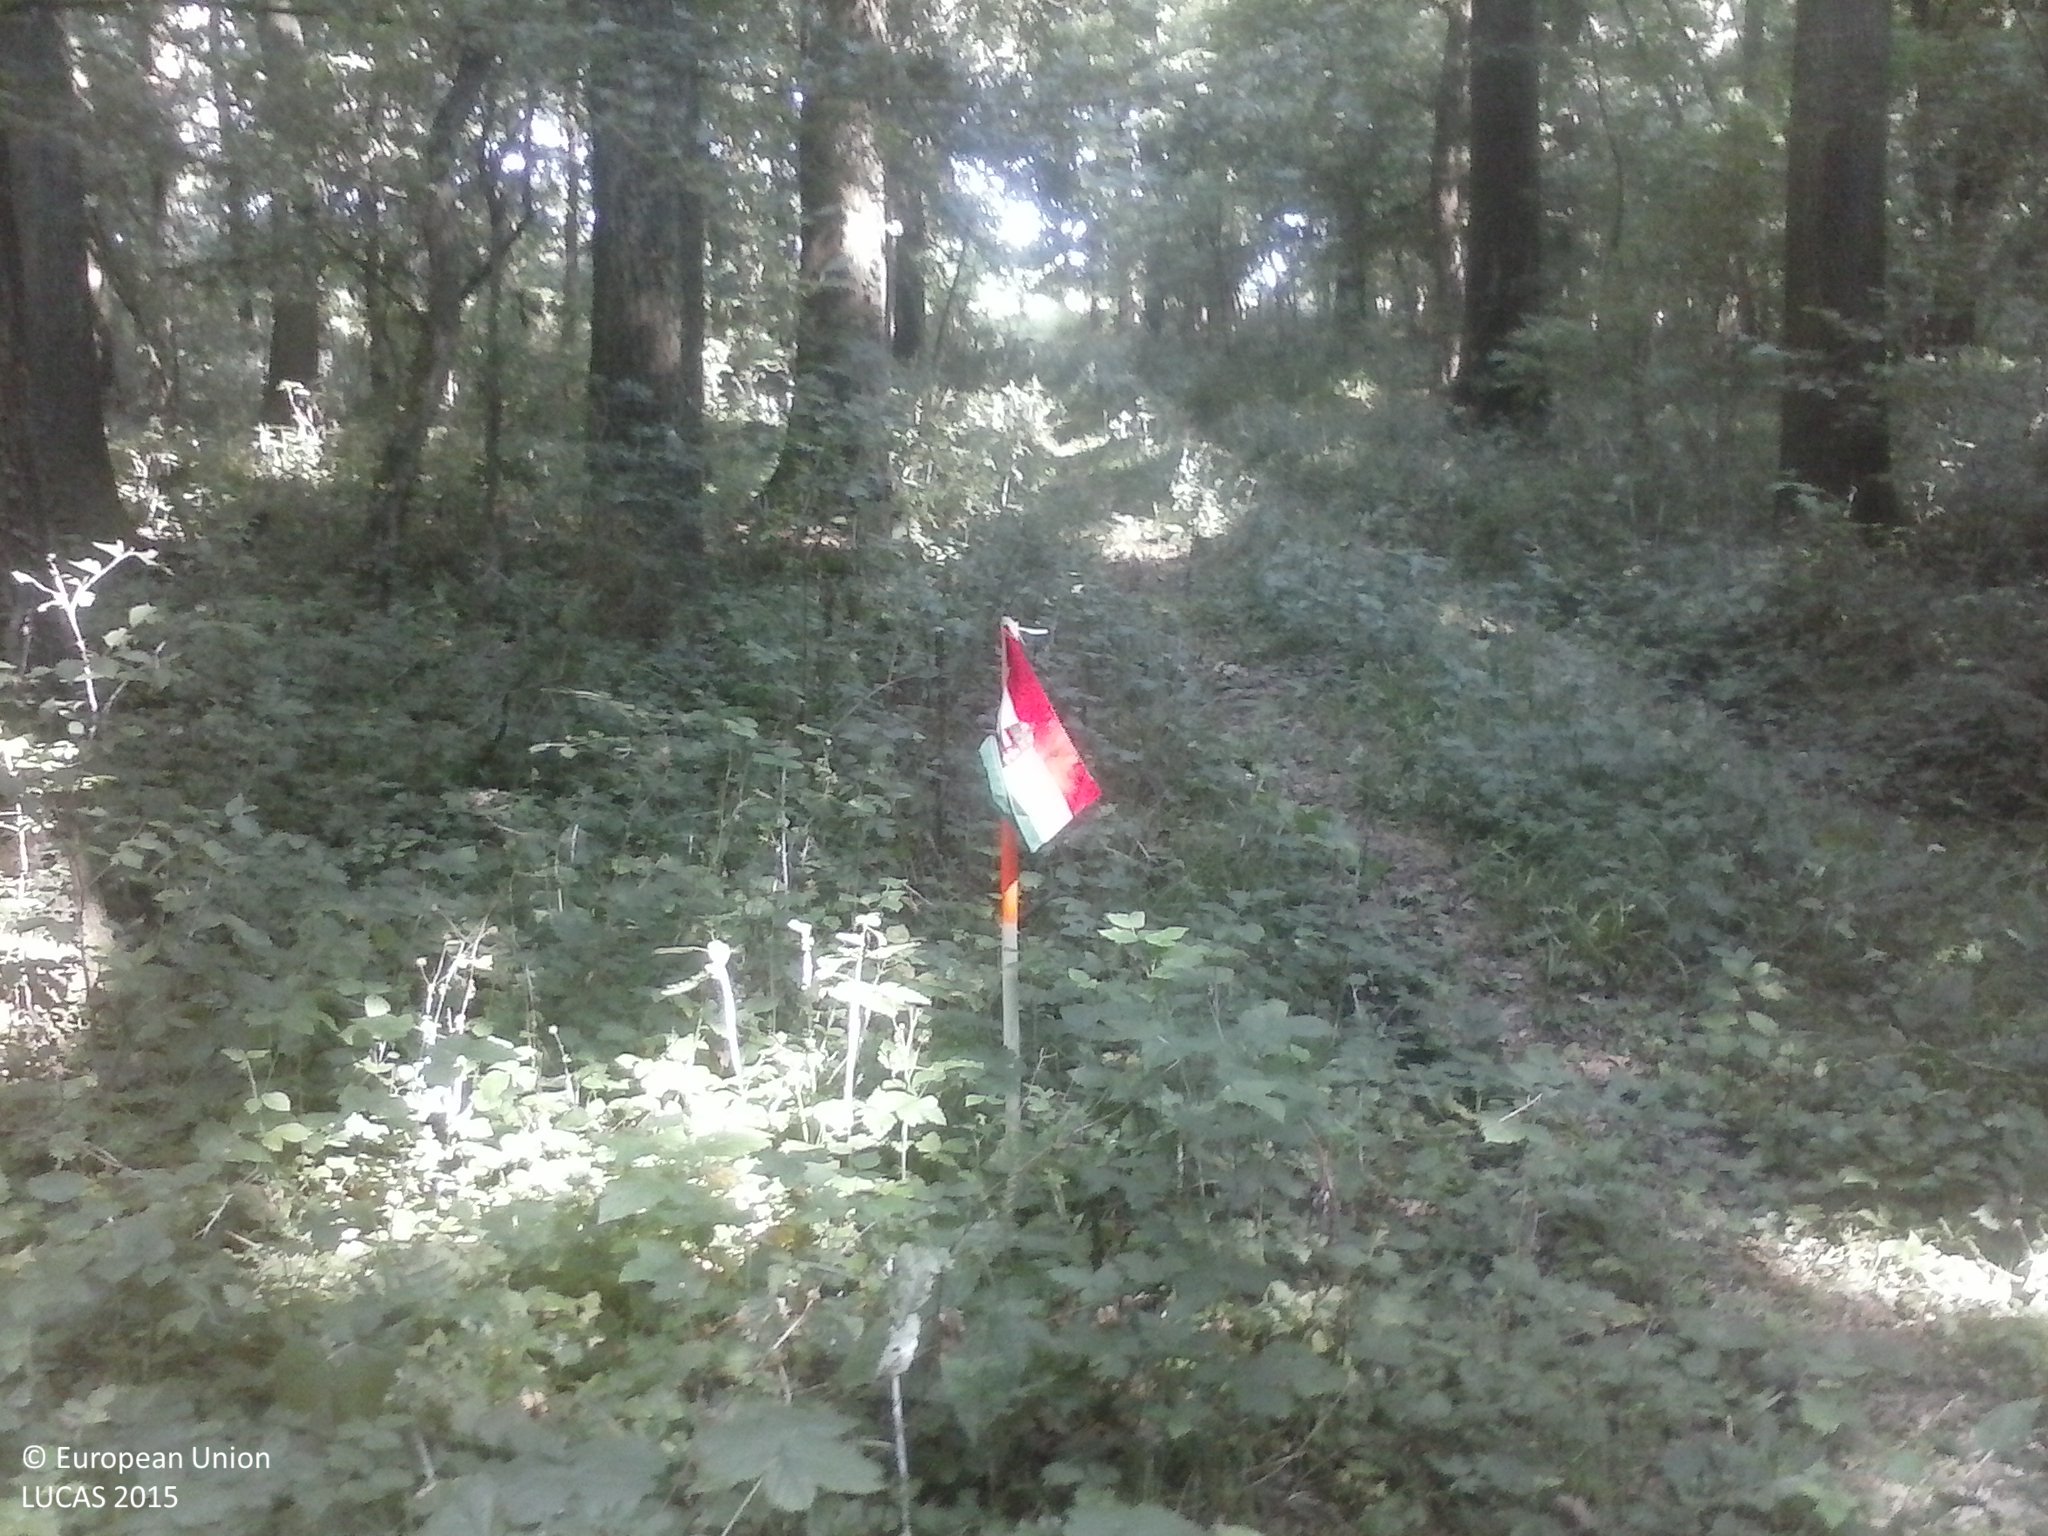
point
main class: Woodland
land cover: Broadleaved woodland
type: mesophytic deciduous forest
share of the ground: > 75 %
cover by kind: broadleaved forest trees 90 %, shrubs 5 %, herbaceous plants 5 %
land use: Forestry
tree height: > 5 m
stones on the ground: < 10 %
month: August
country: HU
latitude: 45.9926
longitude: 17.8157
